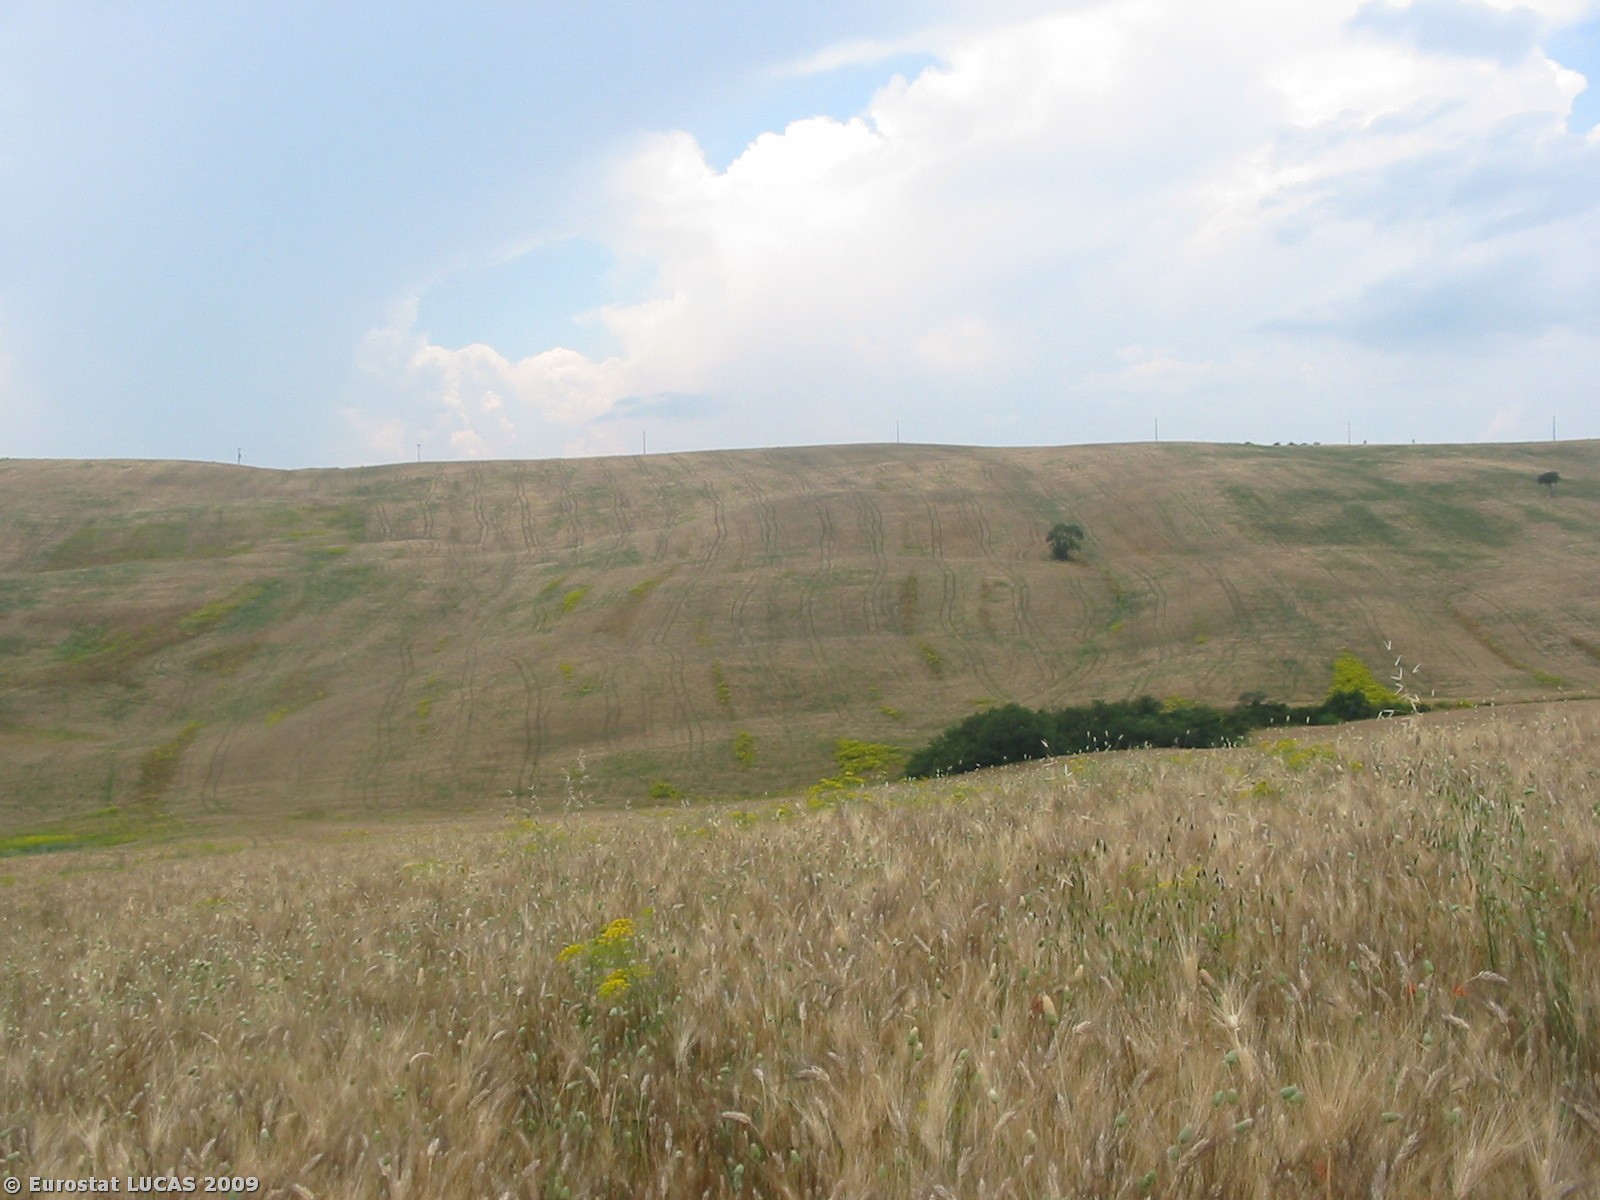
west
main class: Cropland
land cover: Durum wheat
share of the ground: > 75 %
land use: Agriculture (excluding fallow land and kitchen gardens)
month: June
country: IT
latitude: 43.1105
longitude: 11.6295
